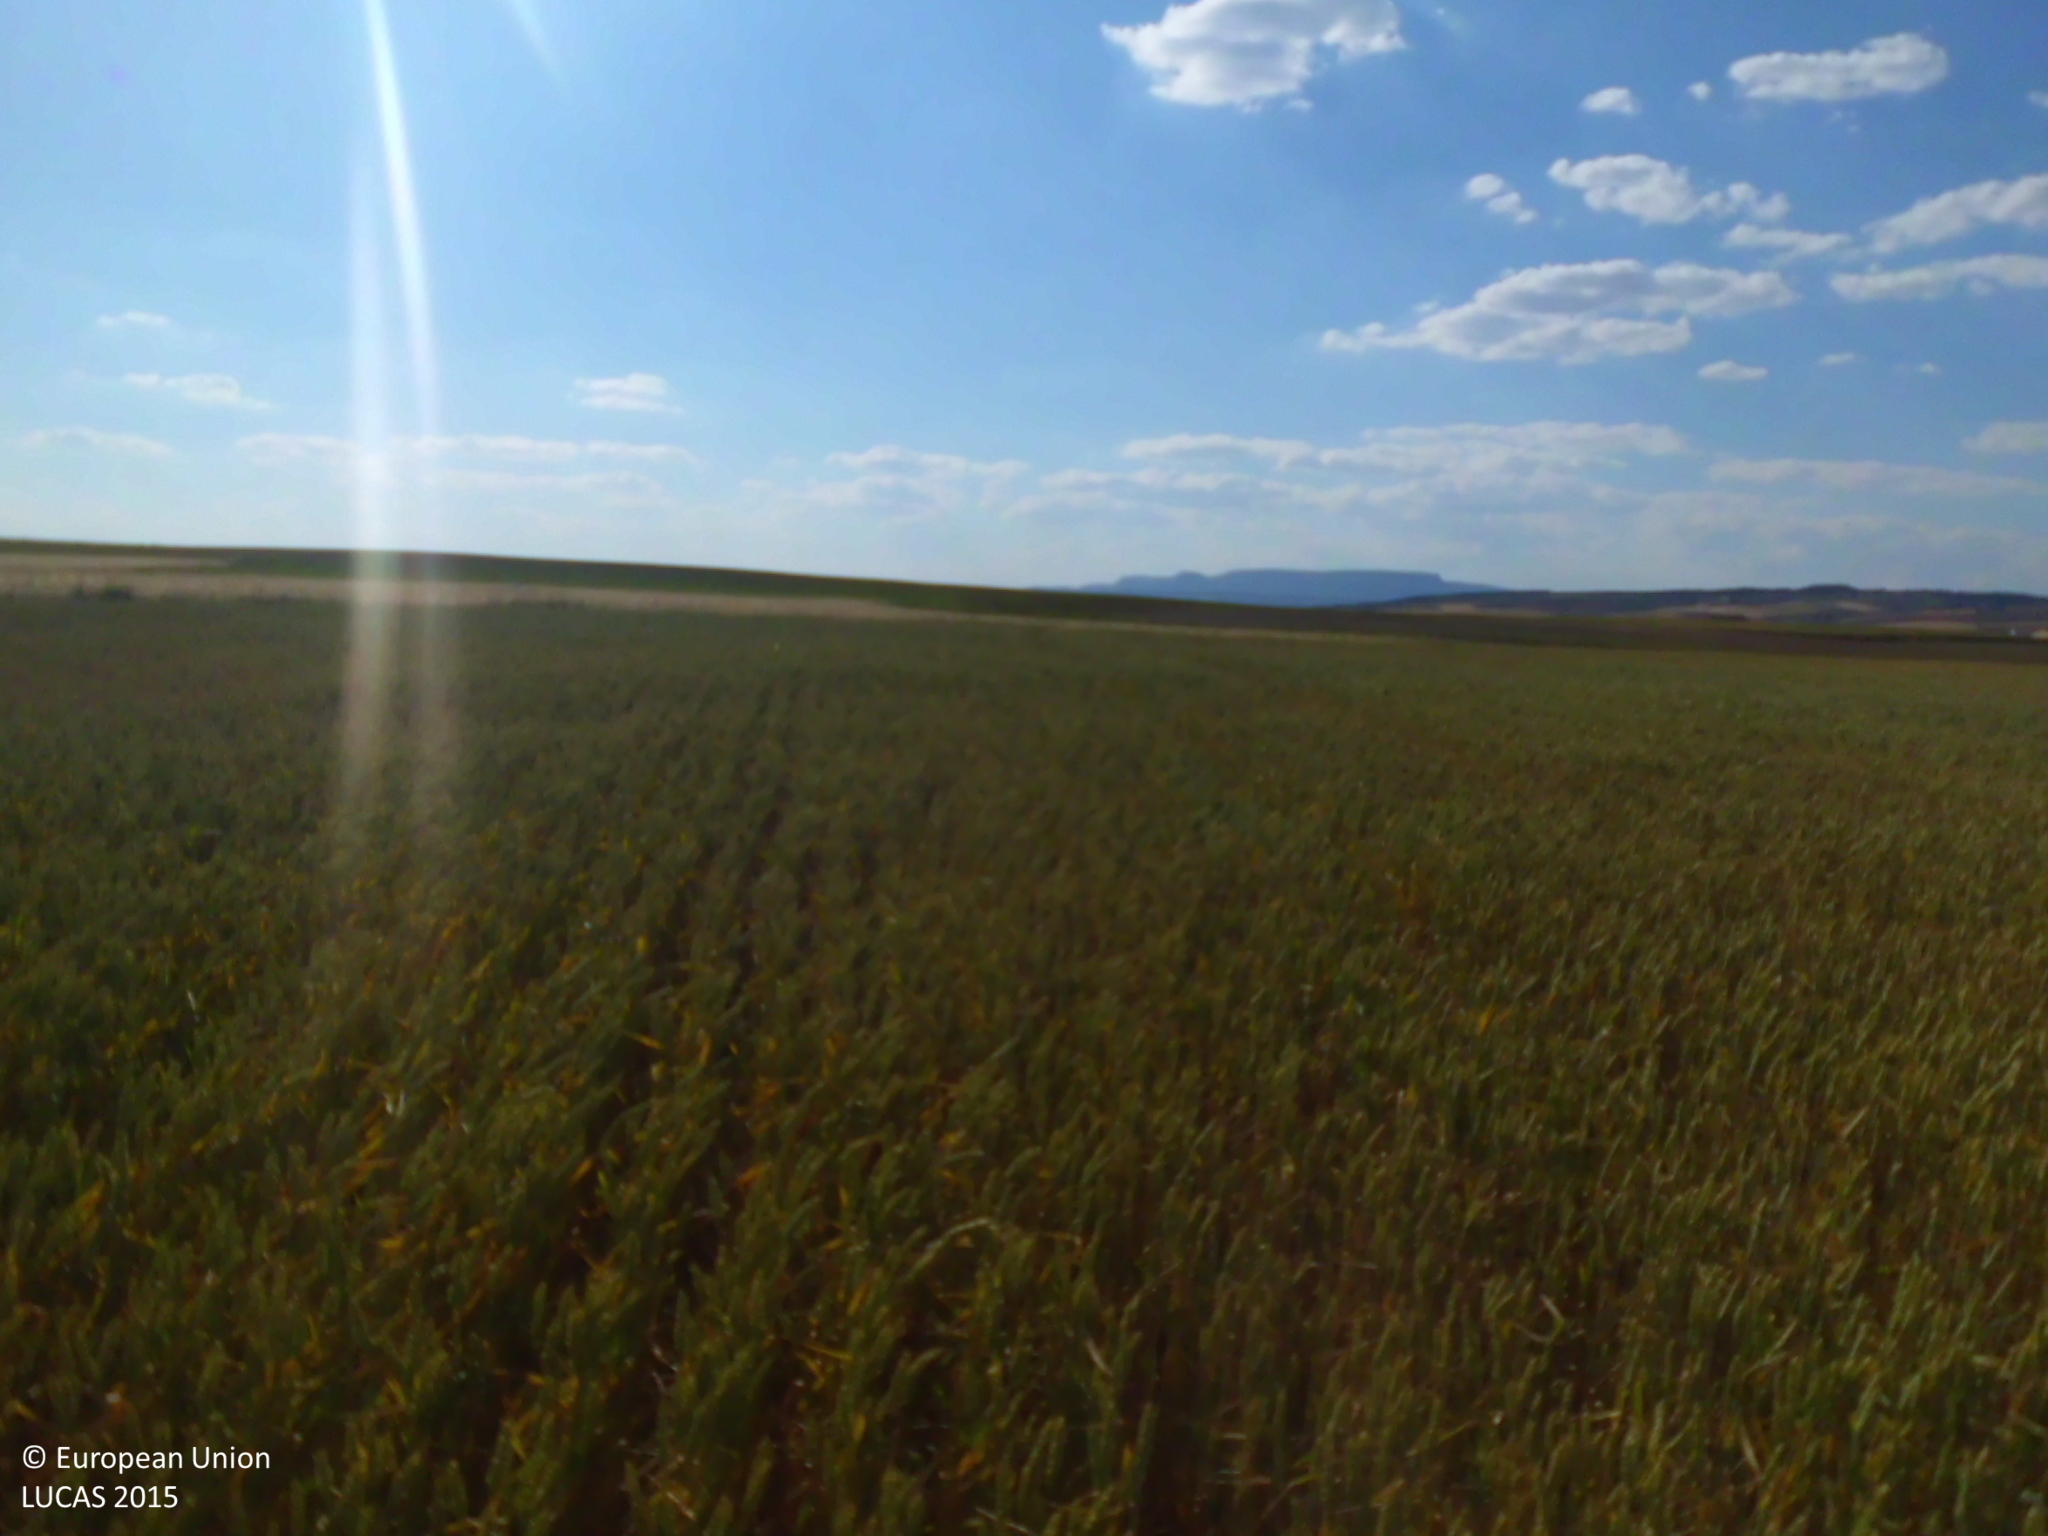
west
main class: Cropland
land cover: Common wheat
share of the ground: > 75 %
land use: Agriculture (excluding fallow land and kitchen gardens)
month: June
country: ES
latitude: 42.5706
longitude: -4.0167
